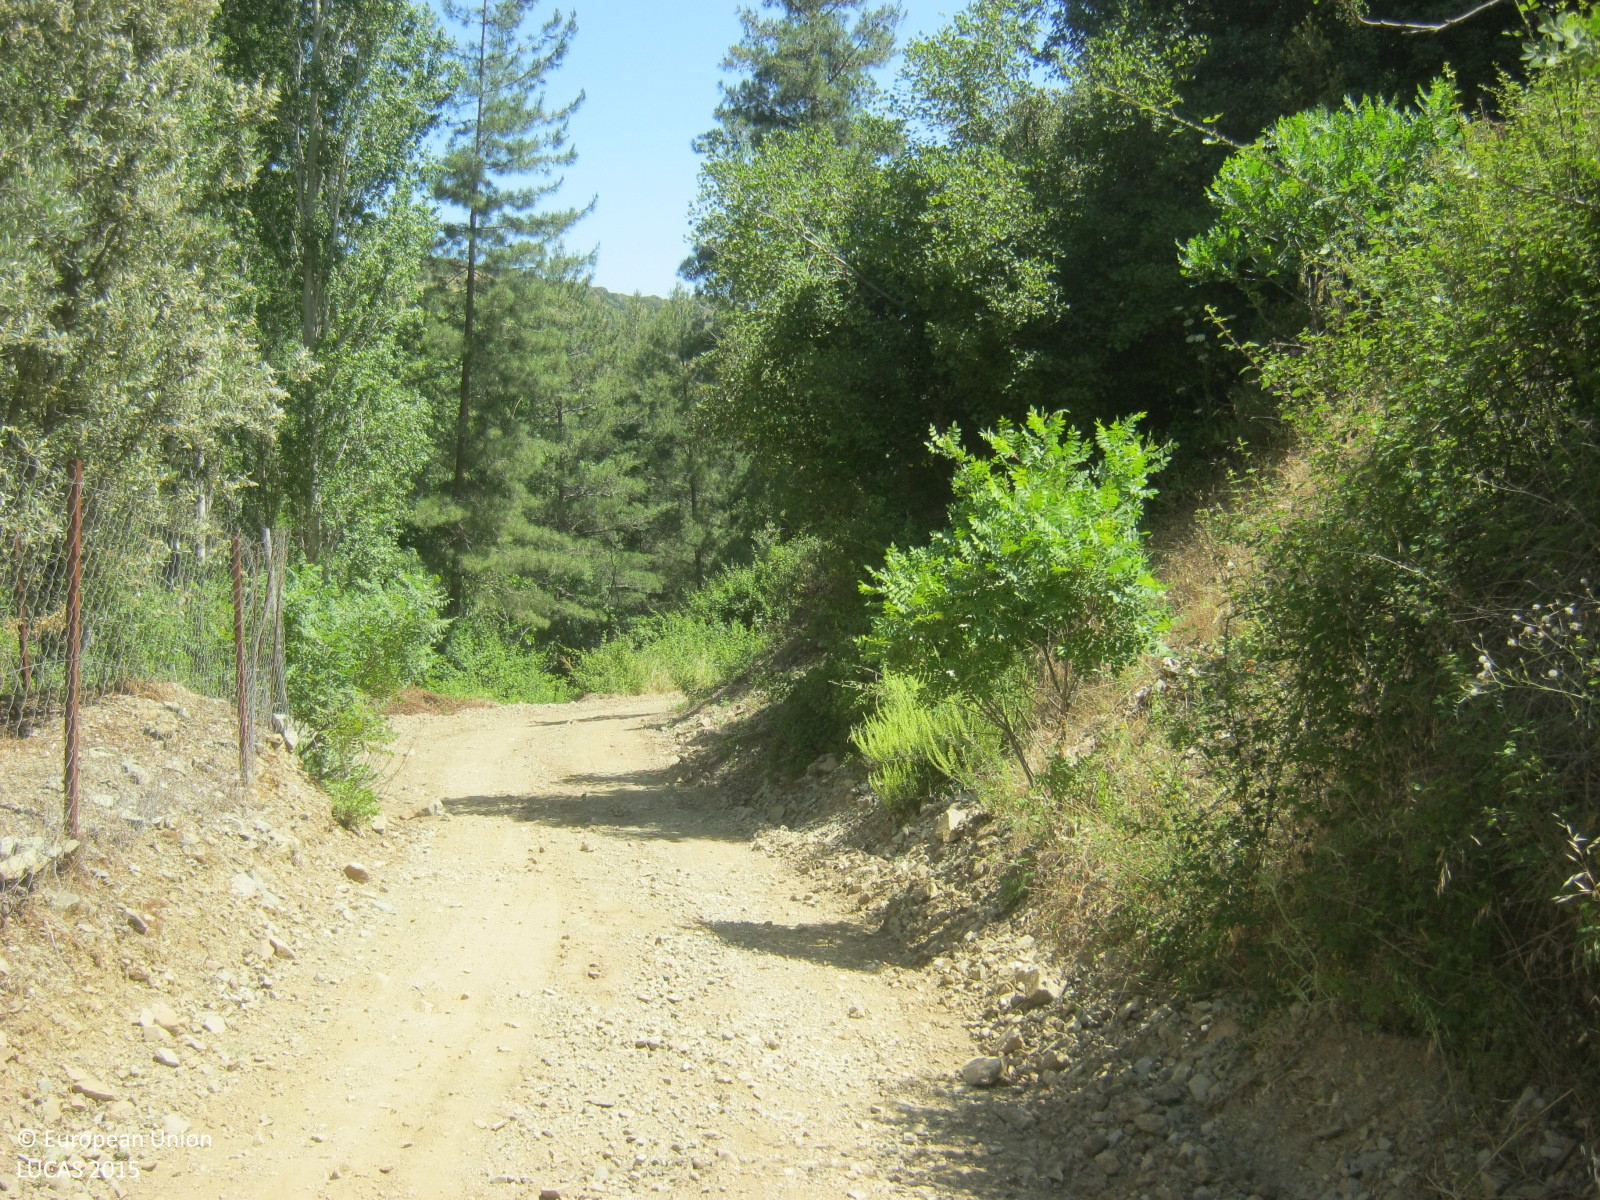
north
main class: Cropland
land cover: Olive groves
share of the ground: 50 - 75 %
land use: Agriculture (excluding fallow land and kitchen gardens)
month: June
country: CY
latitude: 34.9919
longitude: 32.8117
